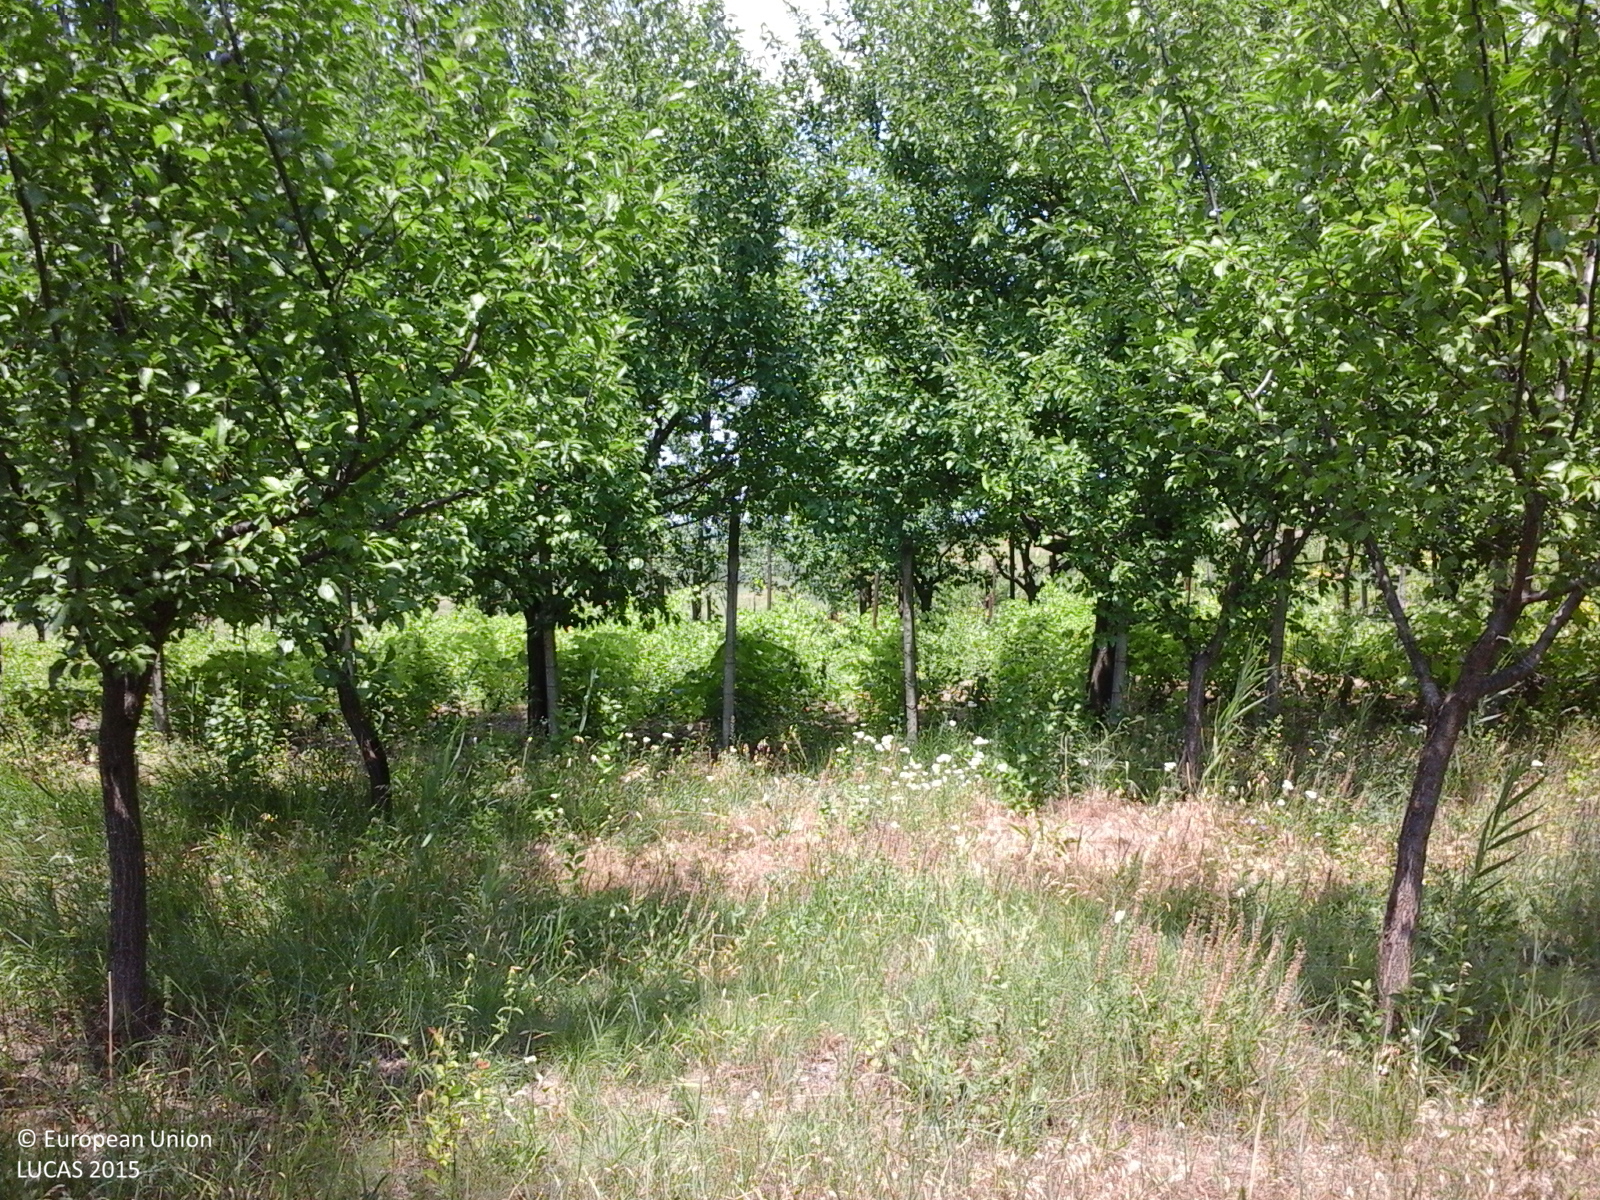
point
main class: Cropland
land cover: Vineyards
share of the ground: > 75 %
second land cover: Other bare soil
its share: > 75 %
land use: Agriculture (excluding fallow land and kitchen gardens)
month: June
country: RO
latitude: 47.2050
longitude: 27.6663
